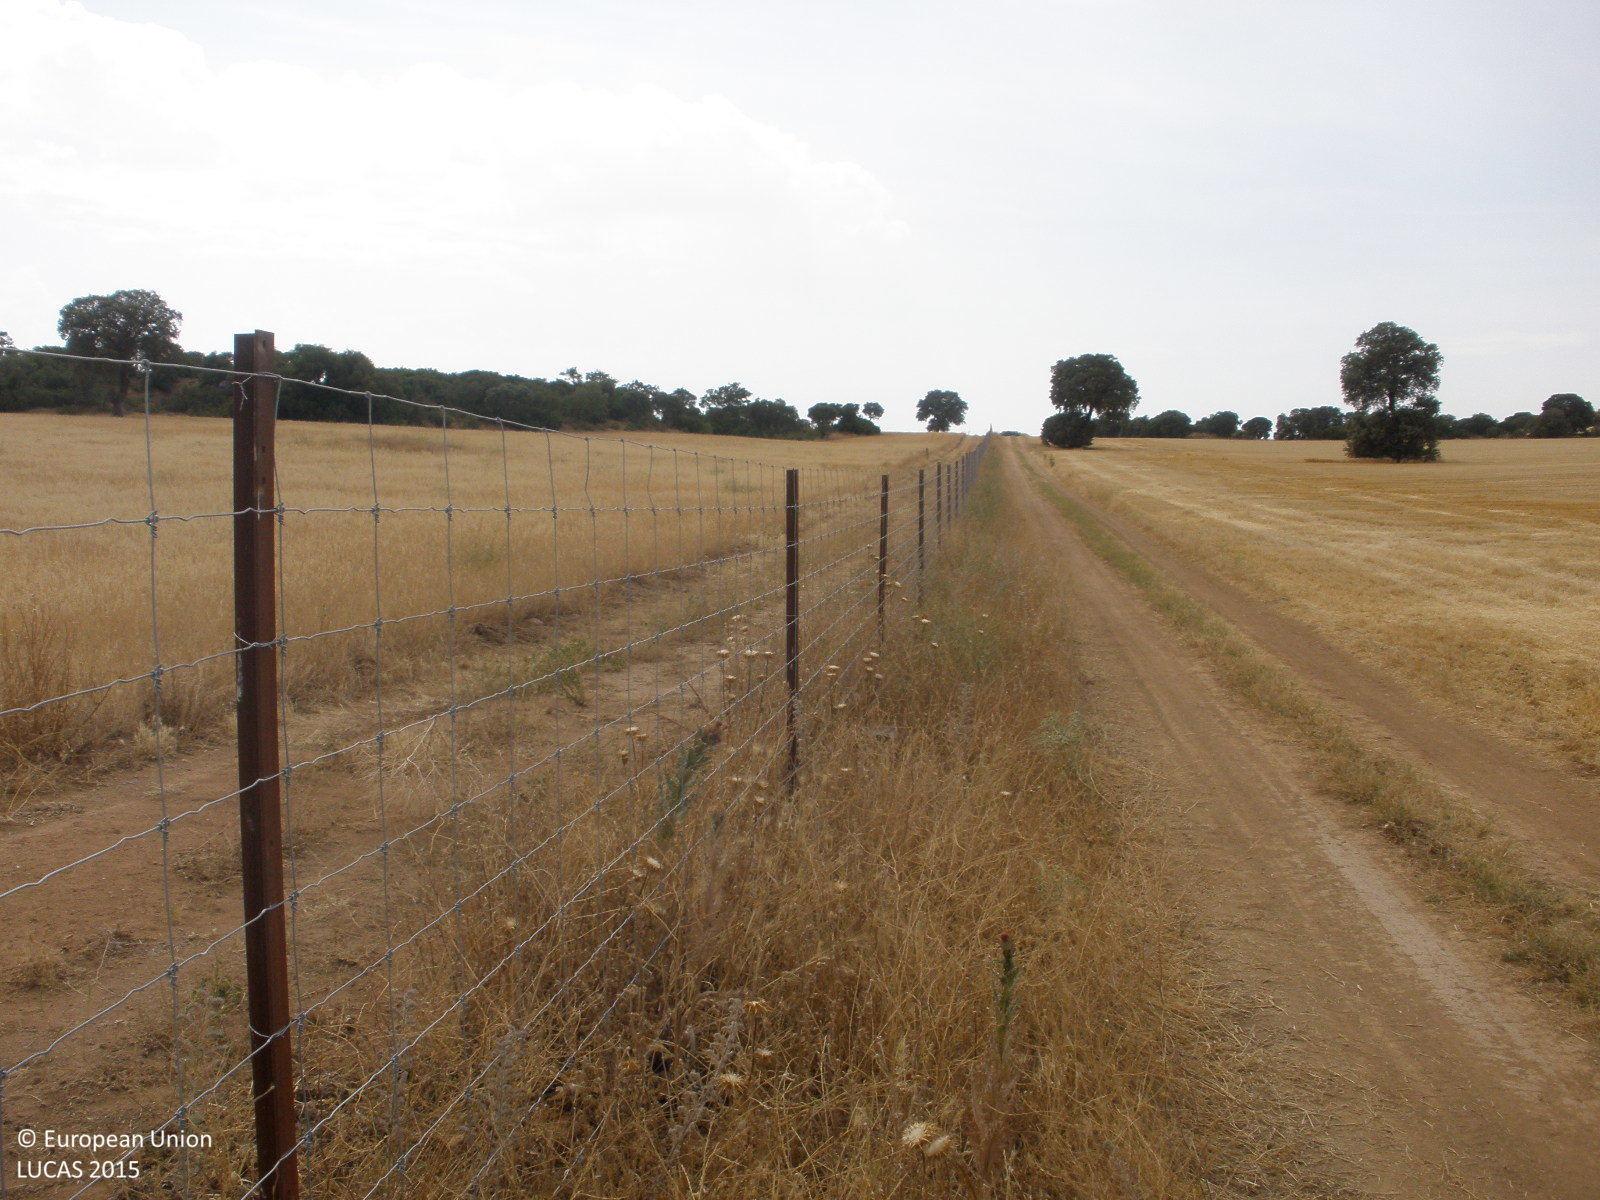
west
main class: Cropland
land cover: Oats
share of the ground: > 75 %
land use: Agriculture (excluding fallow land and kitchen gardens)
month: July
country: ES
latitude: 39.8079
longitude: -3.3527
